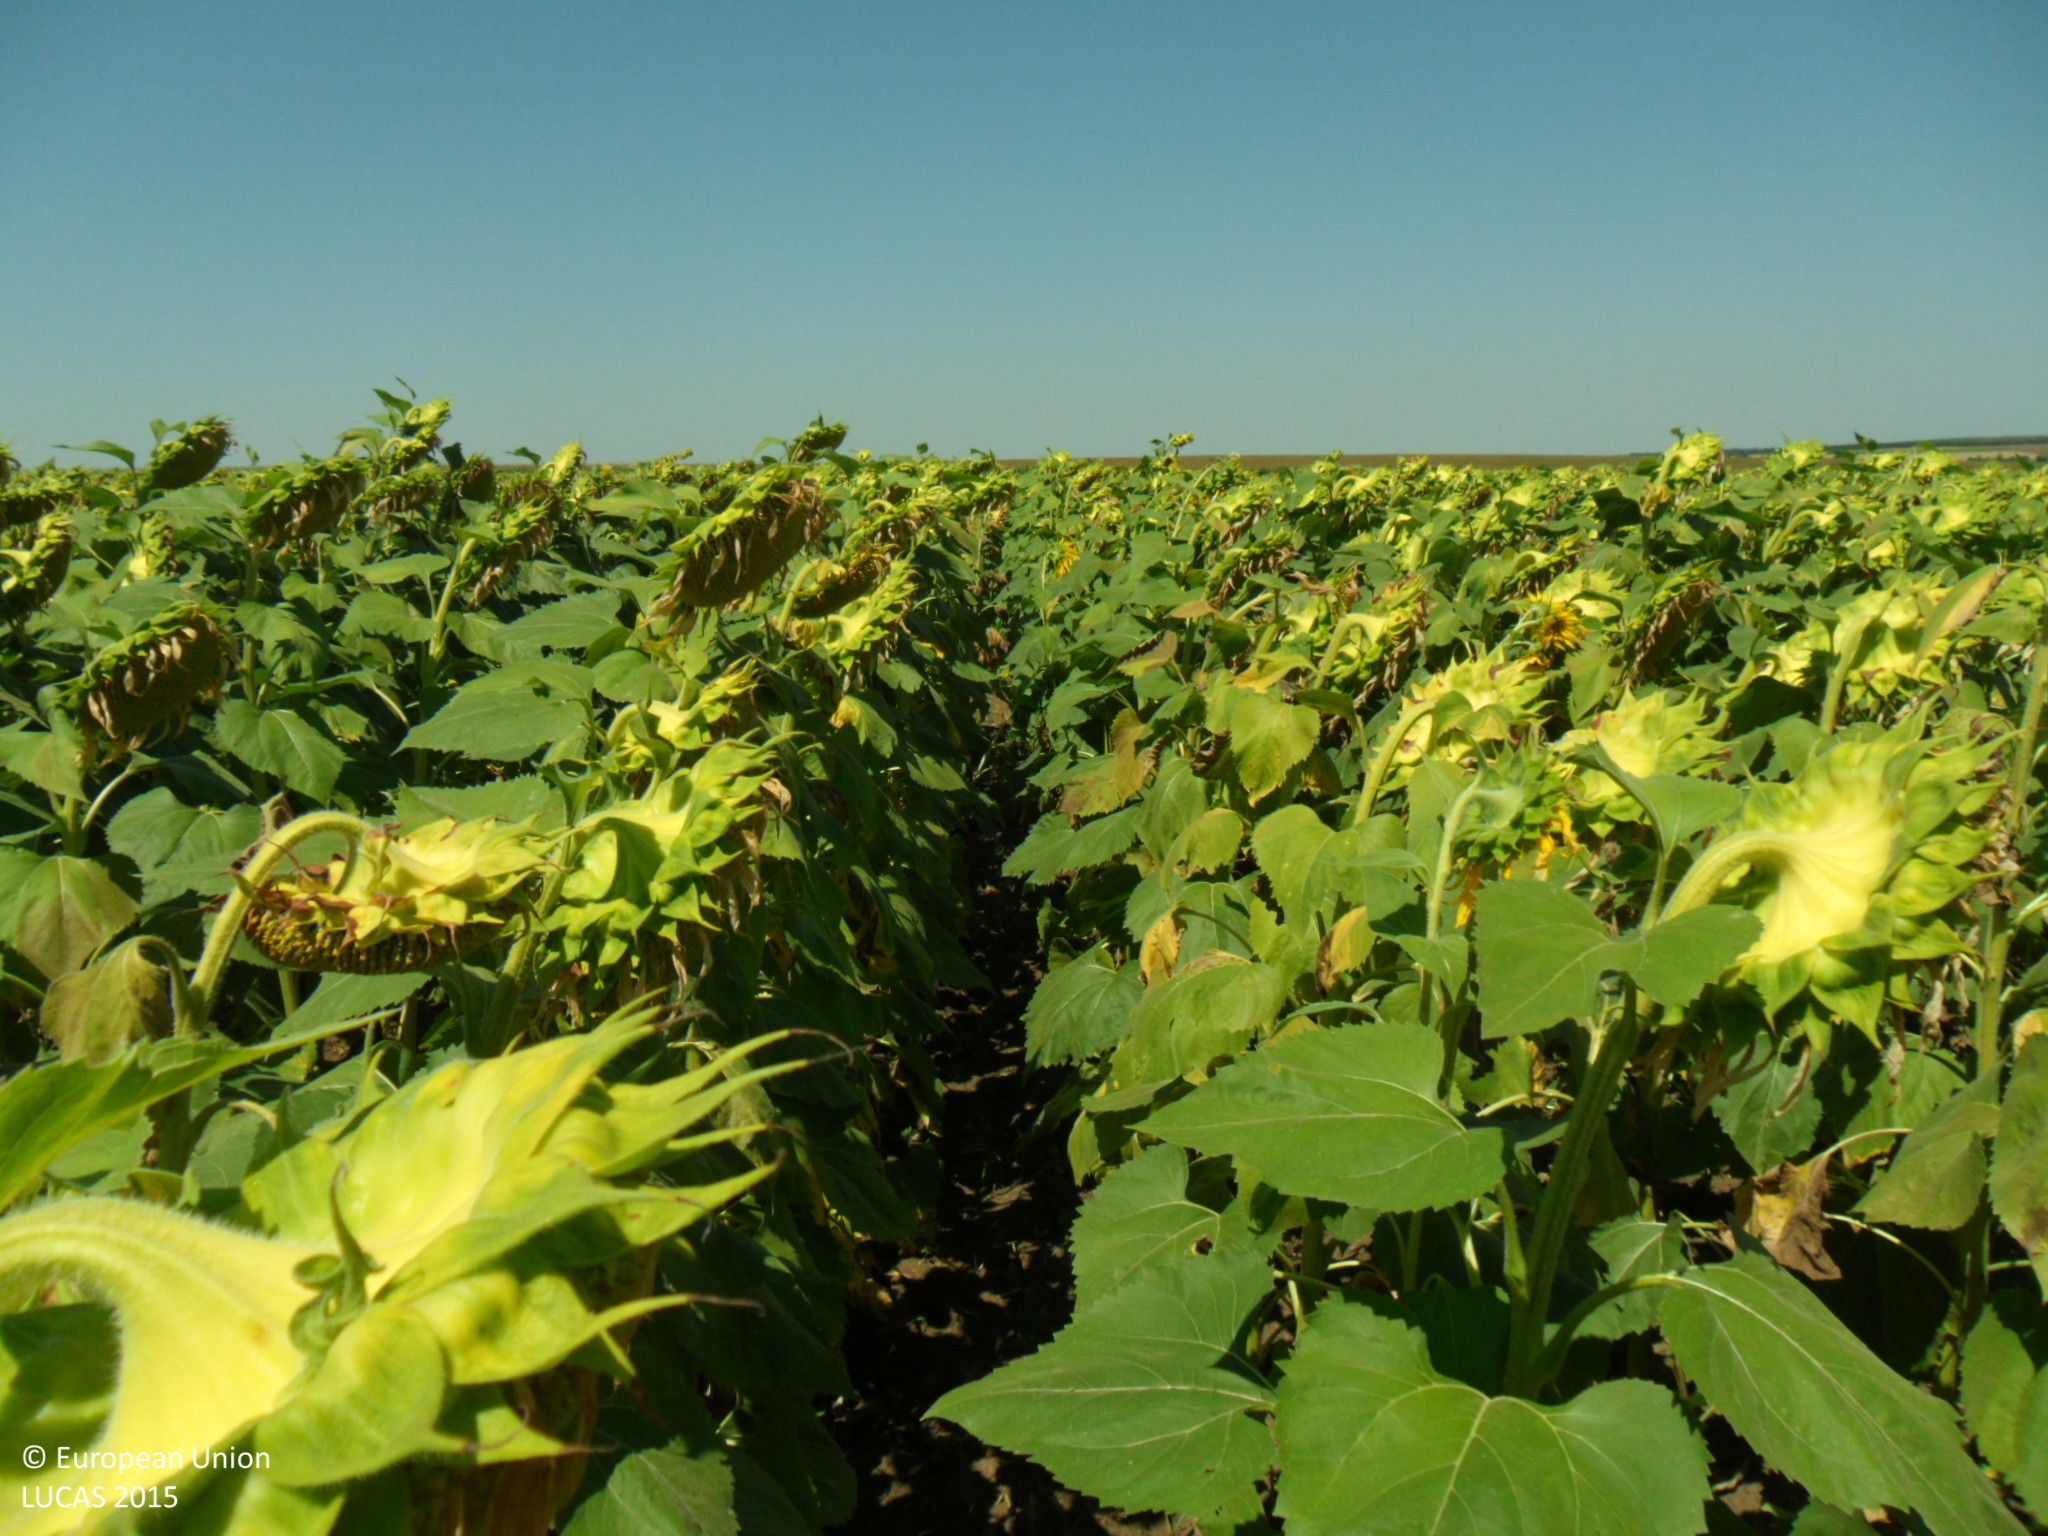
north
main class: Cropland
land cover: Sunflower
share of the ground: > 75 %
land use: Agriculture (excluding fallow land and kitchen gardens)
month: July
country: BG
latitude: 43.8415
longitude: 26.4123
